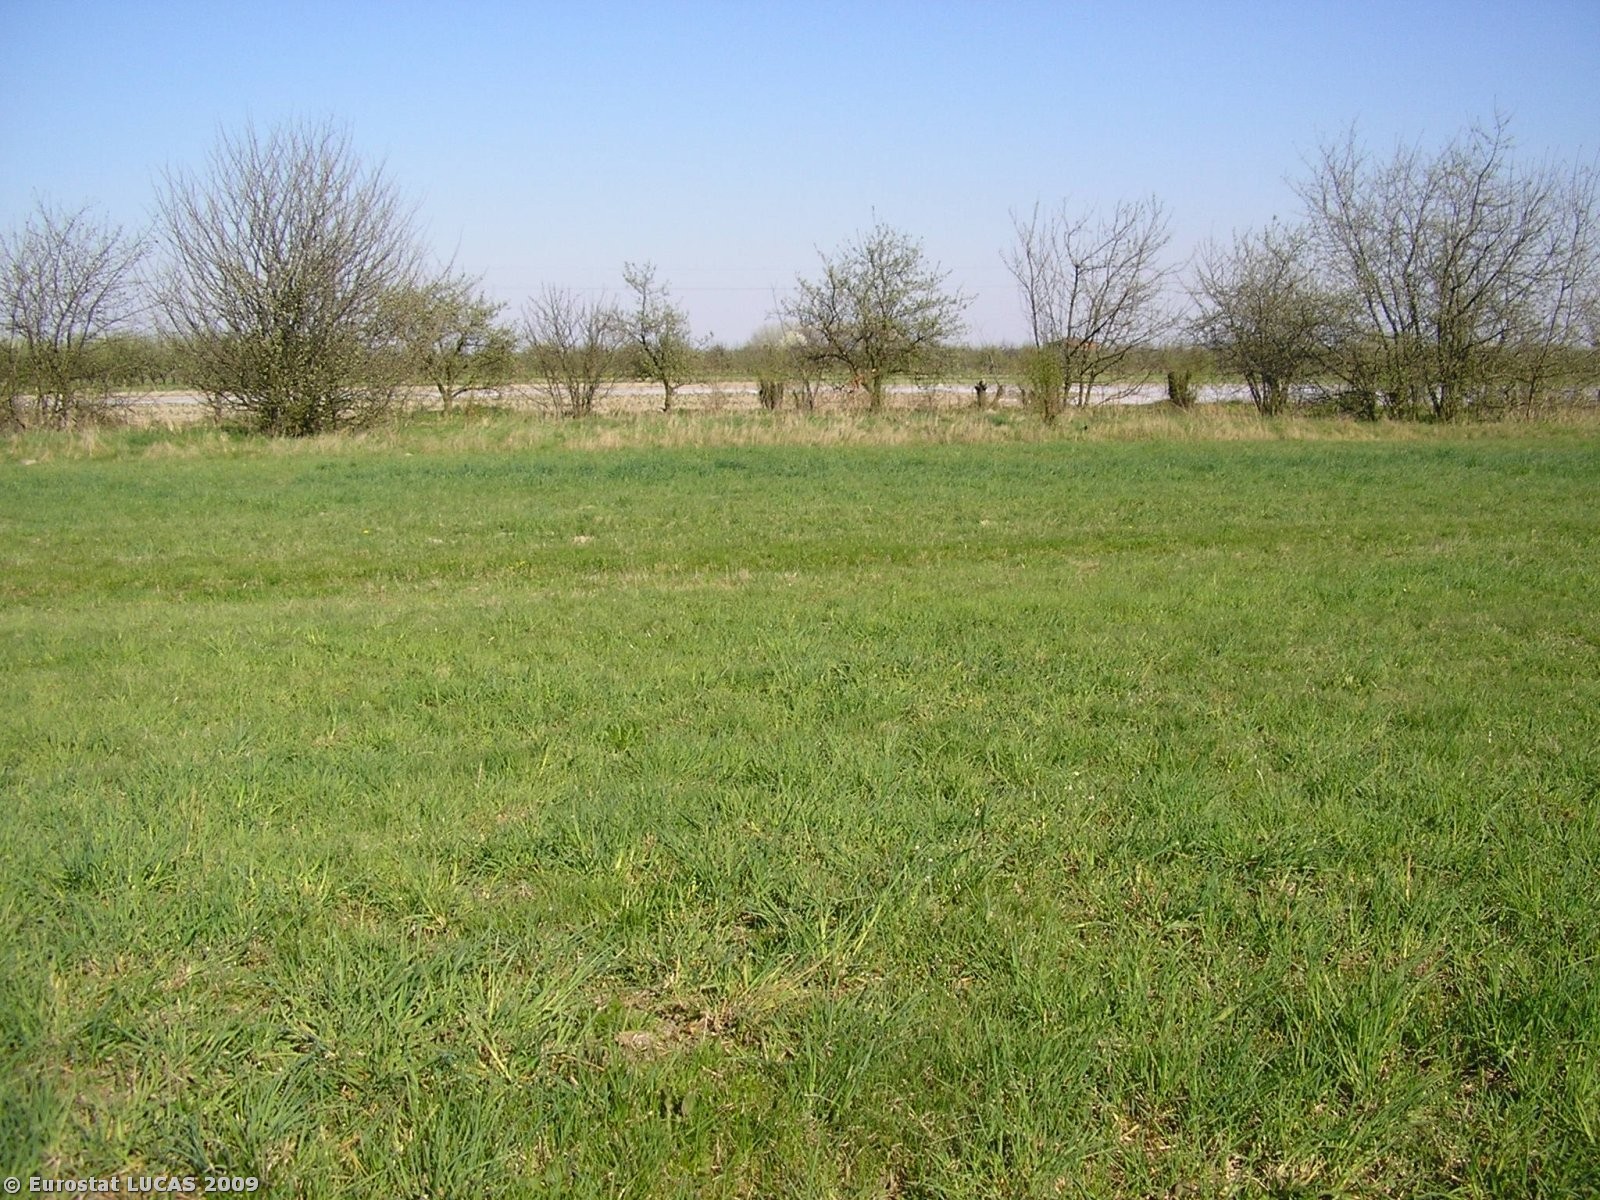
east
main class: Grassland
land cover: Grassland without tree/shrub cover
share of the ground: > 75 %
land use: Agriculture (excluding fallow land and kitchen gardens)
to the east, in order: Grassland without tree/shrub cover; Other fruit trees and berries; Maize; Paved roads, cycling and walking lanes; Barley; Electric lines; Apple fruit; Other fruit trees and berries; Triticale
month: April
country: PL
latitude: 52.1448
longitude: 20.1022
